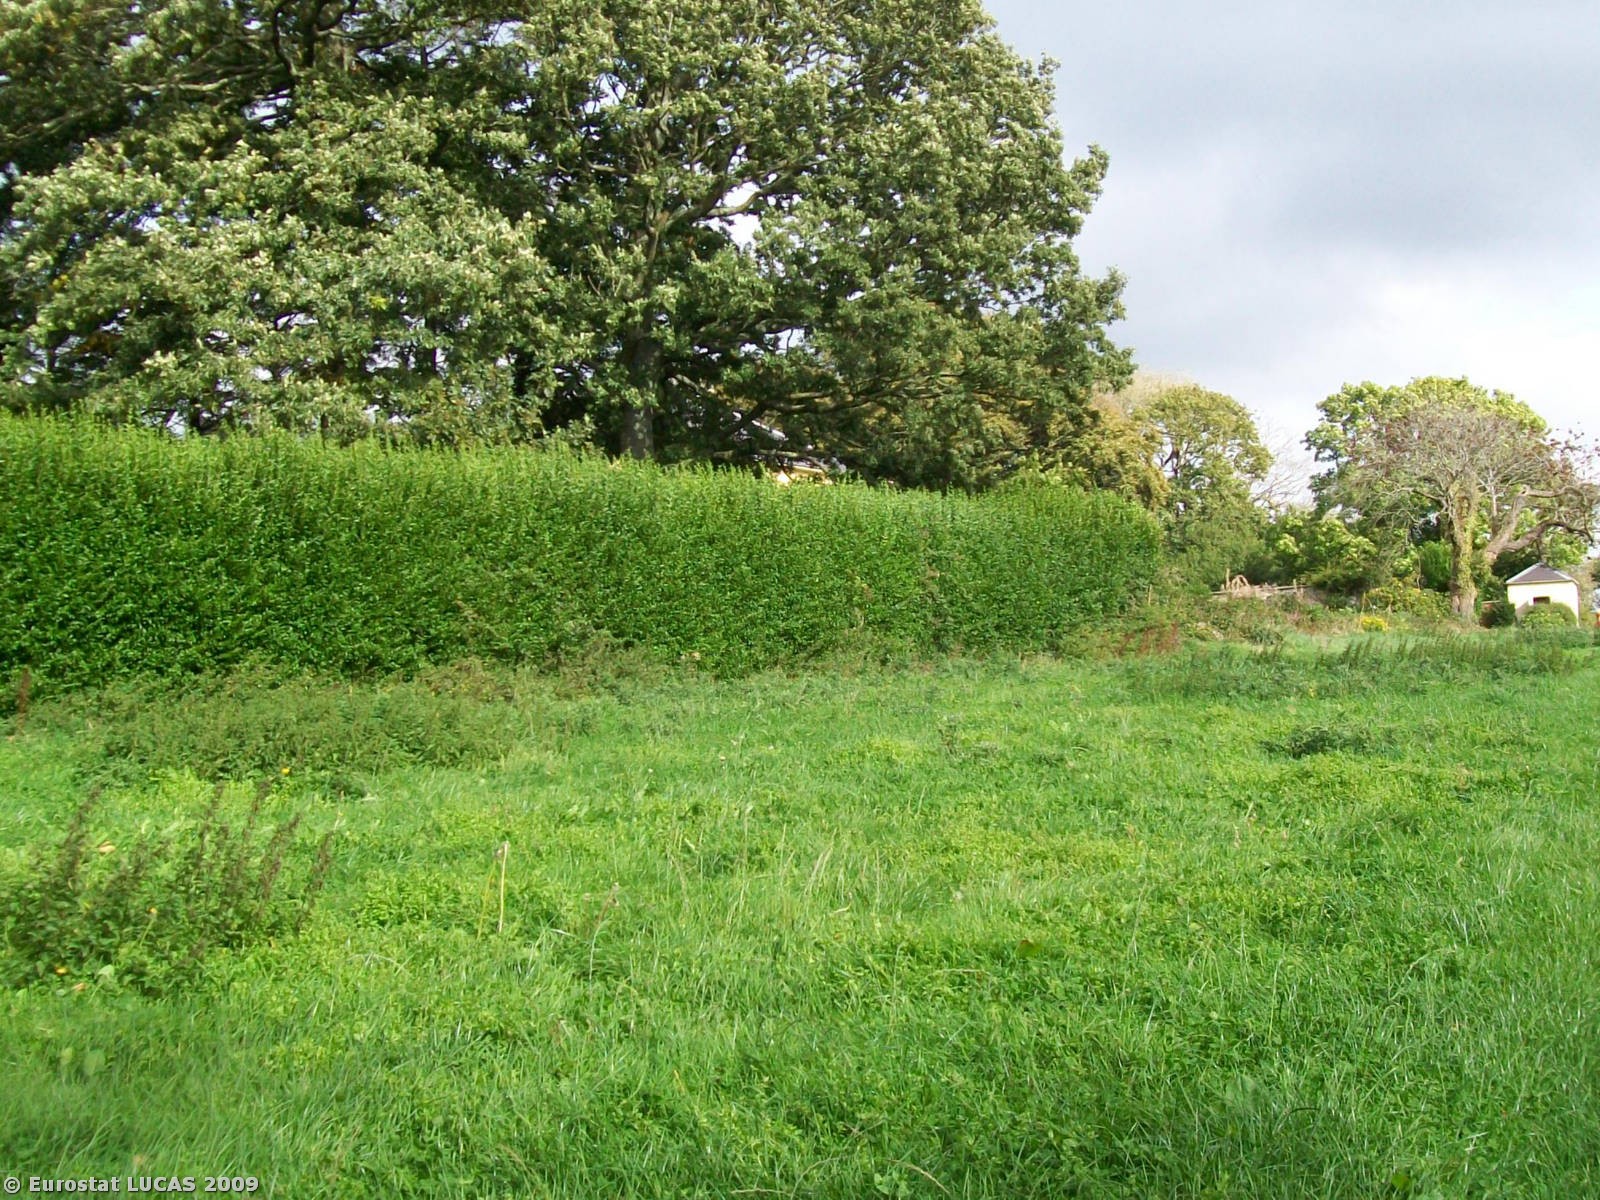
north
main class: Grassland
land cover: Grassland without tree/shrub cover
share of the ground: > 75 %
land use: Agriculture (excluding fallow land and kitchen gardens)
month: September
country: GB
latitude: 52.0257
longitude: -4.8182
